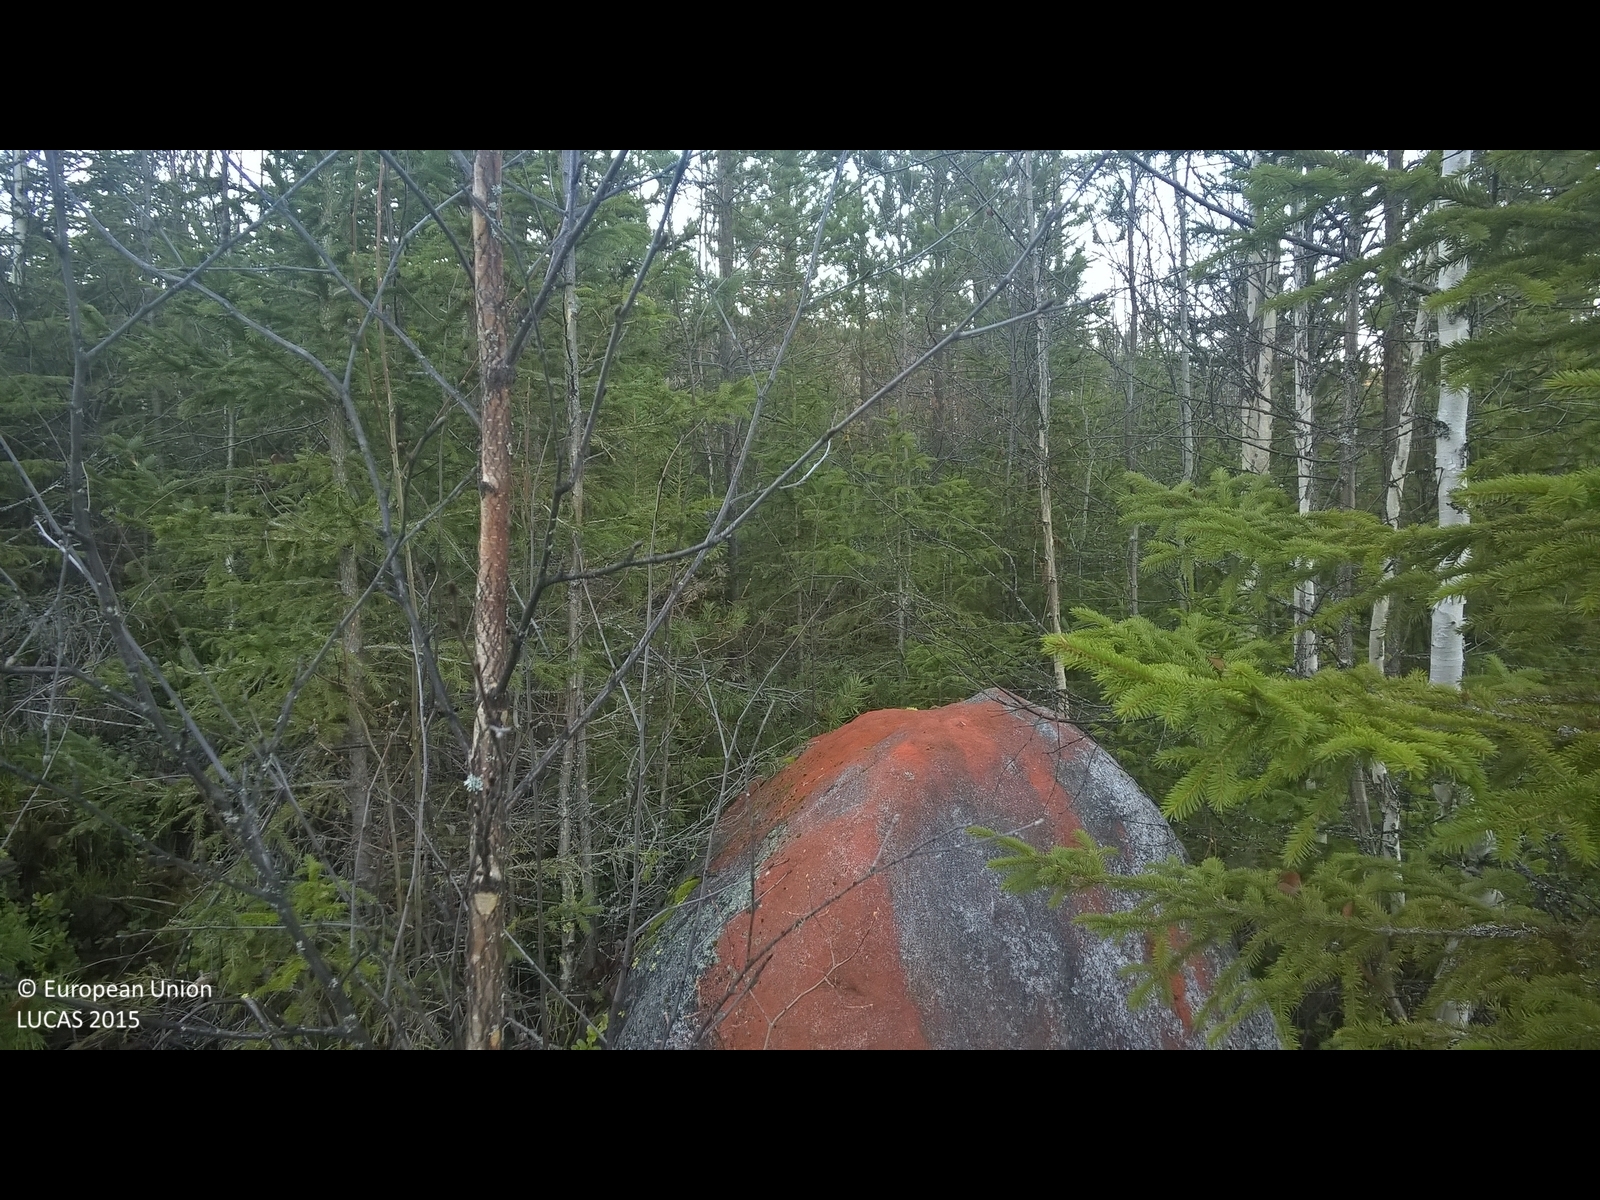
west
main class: Woodland
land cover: Other mixed woodland
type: boreal forest
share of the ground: 50 - 75 %
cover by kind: coniferous forest trees 40 %, lichens and mosses 40 %, broadleaved forest trees 20 %
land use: Forestry
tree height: < 5 m
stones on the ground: < 10 %
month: October
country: SE
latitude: 63.0803
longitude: 15.7775
